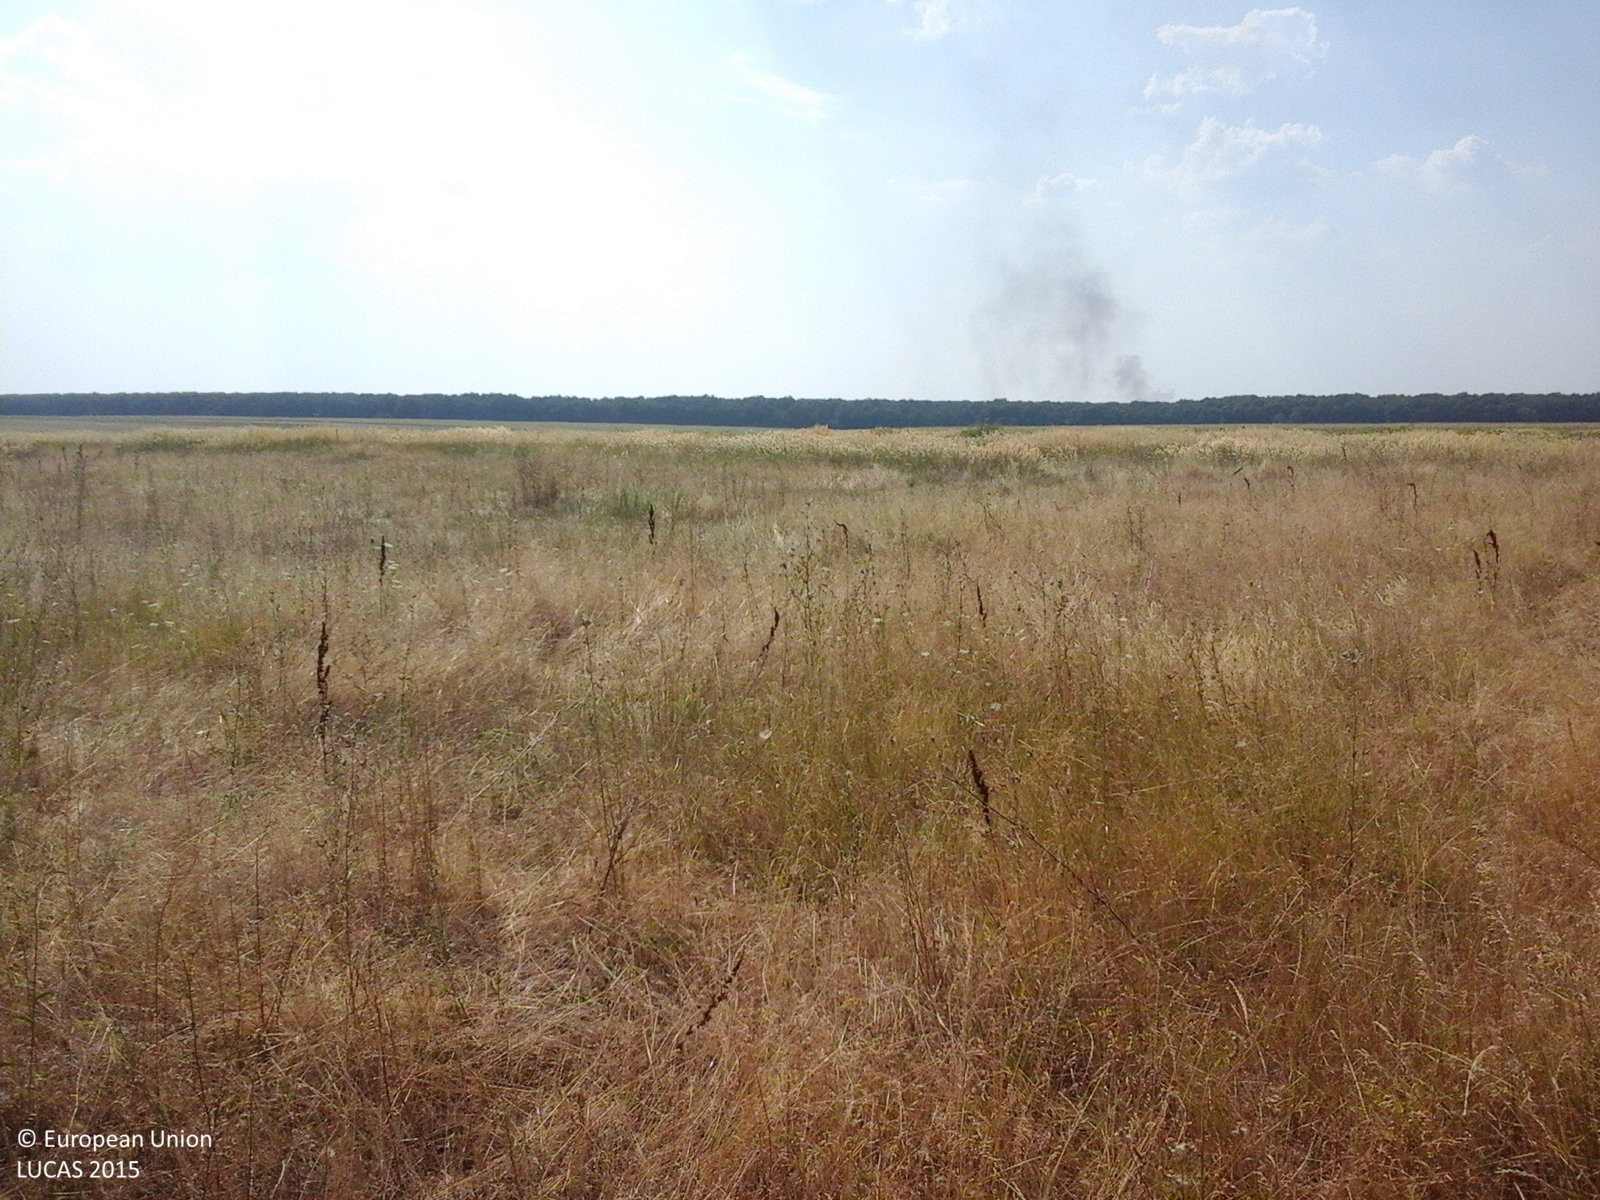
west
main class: Grassland
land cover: Spontaneously vegetated surfaces
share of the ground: > 75 %
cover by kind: herbaceous plants 100 %
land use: Fallow land
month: August
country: RO
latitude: 44.4257
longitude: 23.1228
